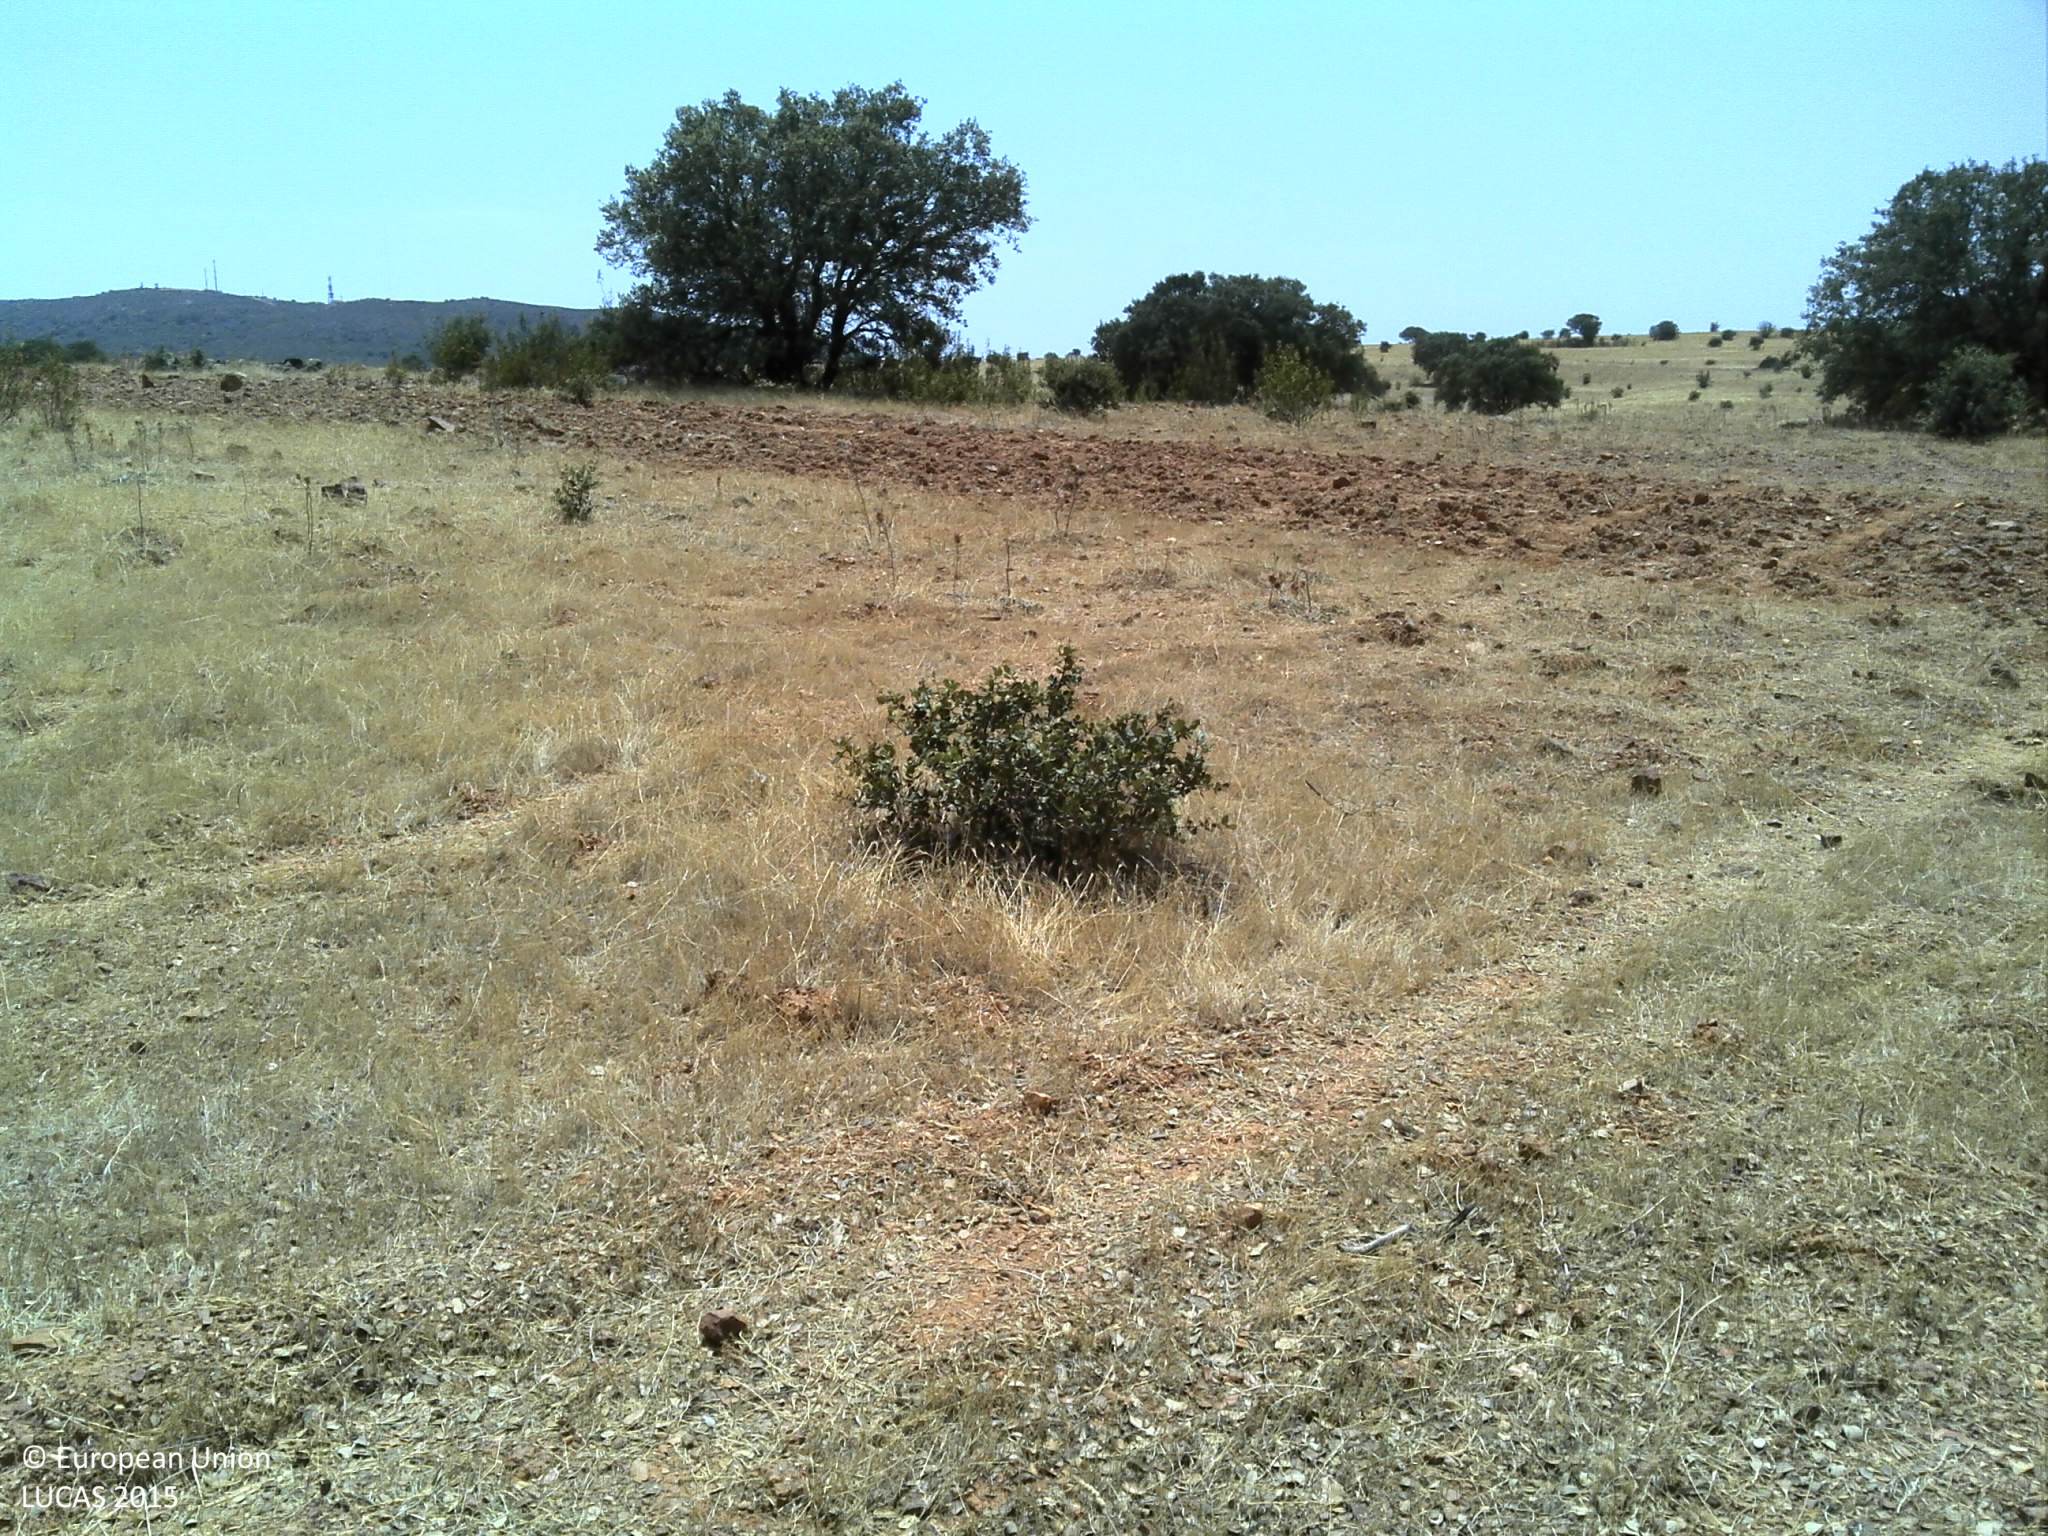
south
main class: Woodland
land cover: Broadleaved woodland
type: broadleaved evergreen forest
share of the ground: 10 - 25 %
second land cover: Grassland without tree/shrub cover
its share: 10 - 25 %
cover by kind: unconsolidated bare surface 55 %, herbaceous plants 25 %, broadleaved forest trees 10 %, shrubs 5 %
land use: Forestry
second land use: Agriculture (excluding fallow land and kitchen gardens)
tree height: > 5 m
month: July
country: PT
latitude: 37.7236
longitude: -7.7755
